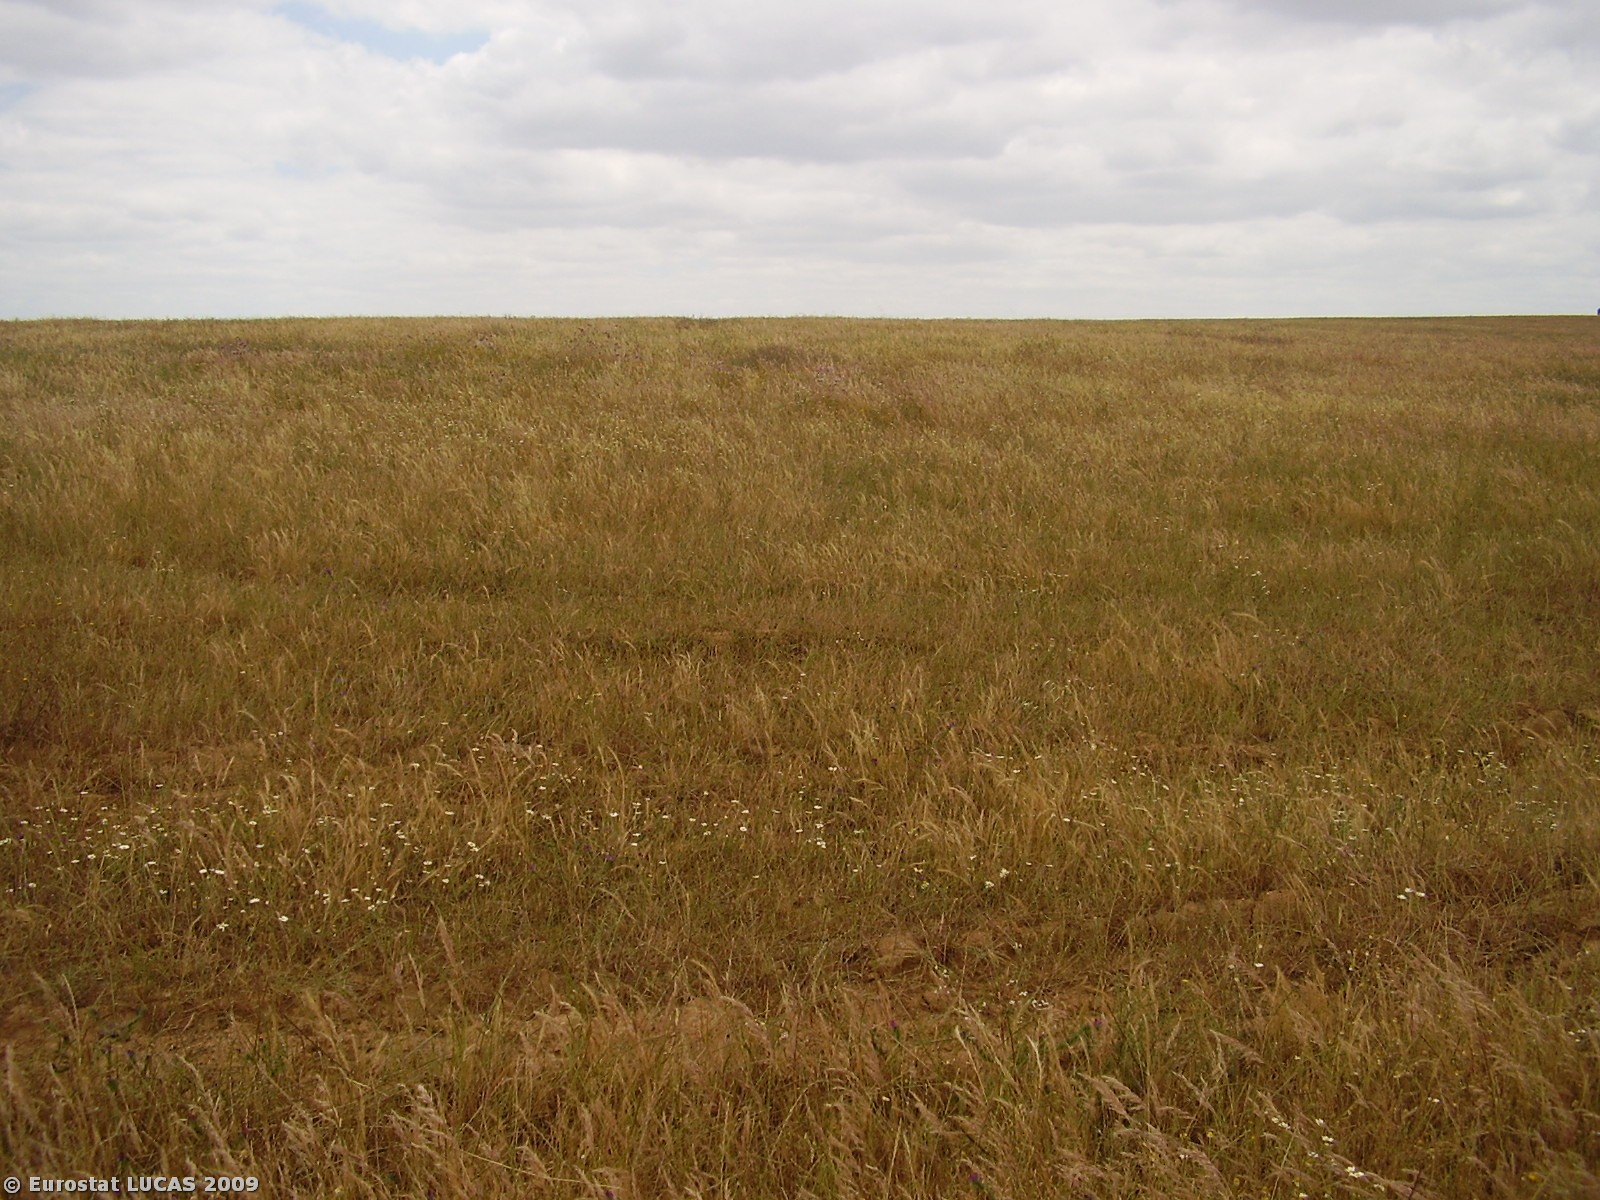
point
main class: Grassland
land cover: Grassland without tree/shrub cover
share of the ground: > 75 %
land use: Agriculture (excluding fallow land and kitchen gardens)
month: May
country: PT
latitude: 37.7596
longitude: -7.8780
